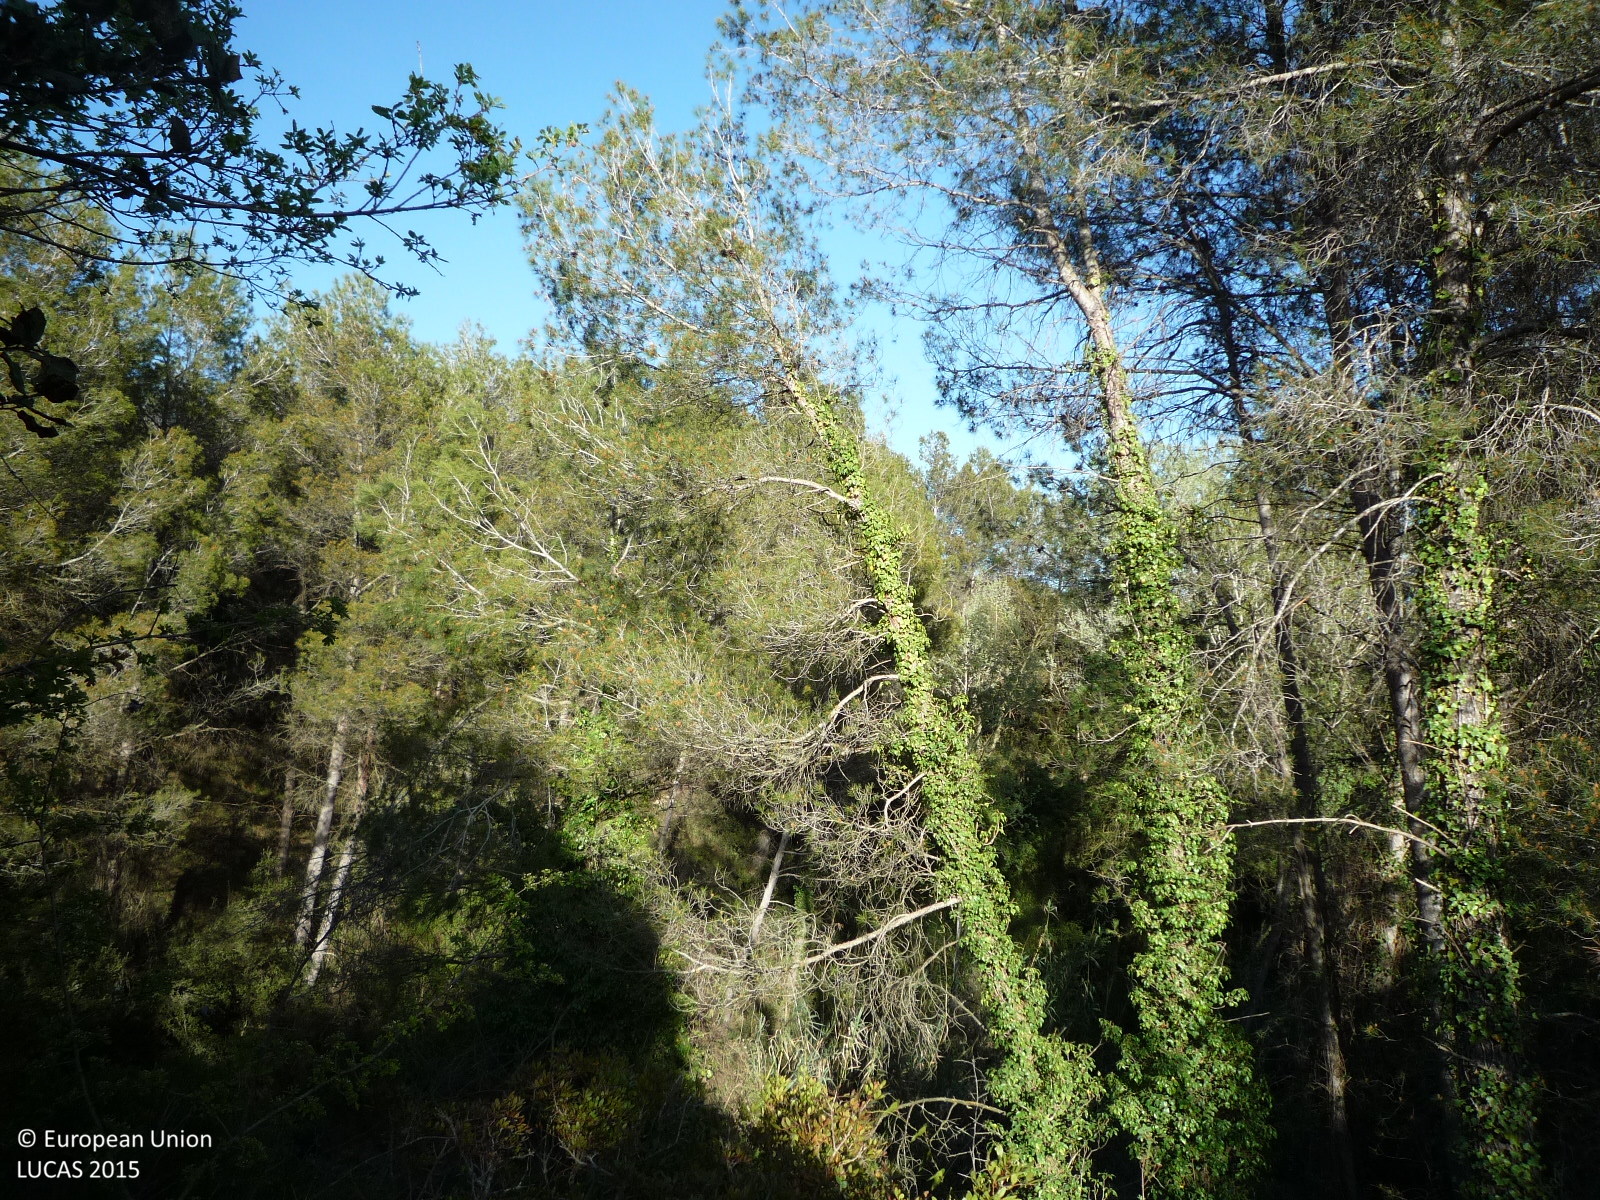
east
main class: Woodland
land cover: Pine dominated mixed woodland
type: coniferous forest of the mediterranean region
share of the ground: > 75 %
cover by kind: coniferous forest trees 55 %, broadleaved forest trees 30 %, shrubs 15 %
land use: Semi-natural and natural areas not in use
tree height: > 5 m
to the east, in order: Pine dominated mixed woodland; Rivers and streams; Pine dominated mixed woodland; Tracks; Electric lines; Tracks; Grassland with sparse tree/shrub cover; Vineyards; Grassland with sparse tree/shrub cover; Vineyards; Shrubland with sparse tree cover; Tracks; Grass margins
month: April
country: ES
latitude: 41.4195
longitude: 1.6535
